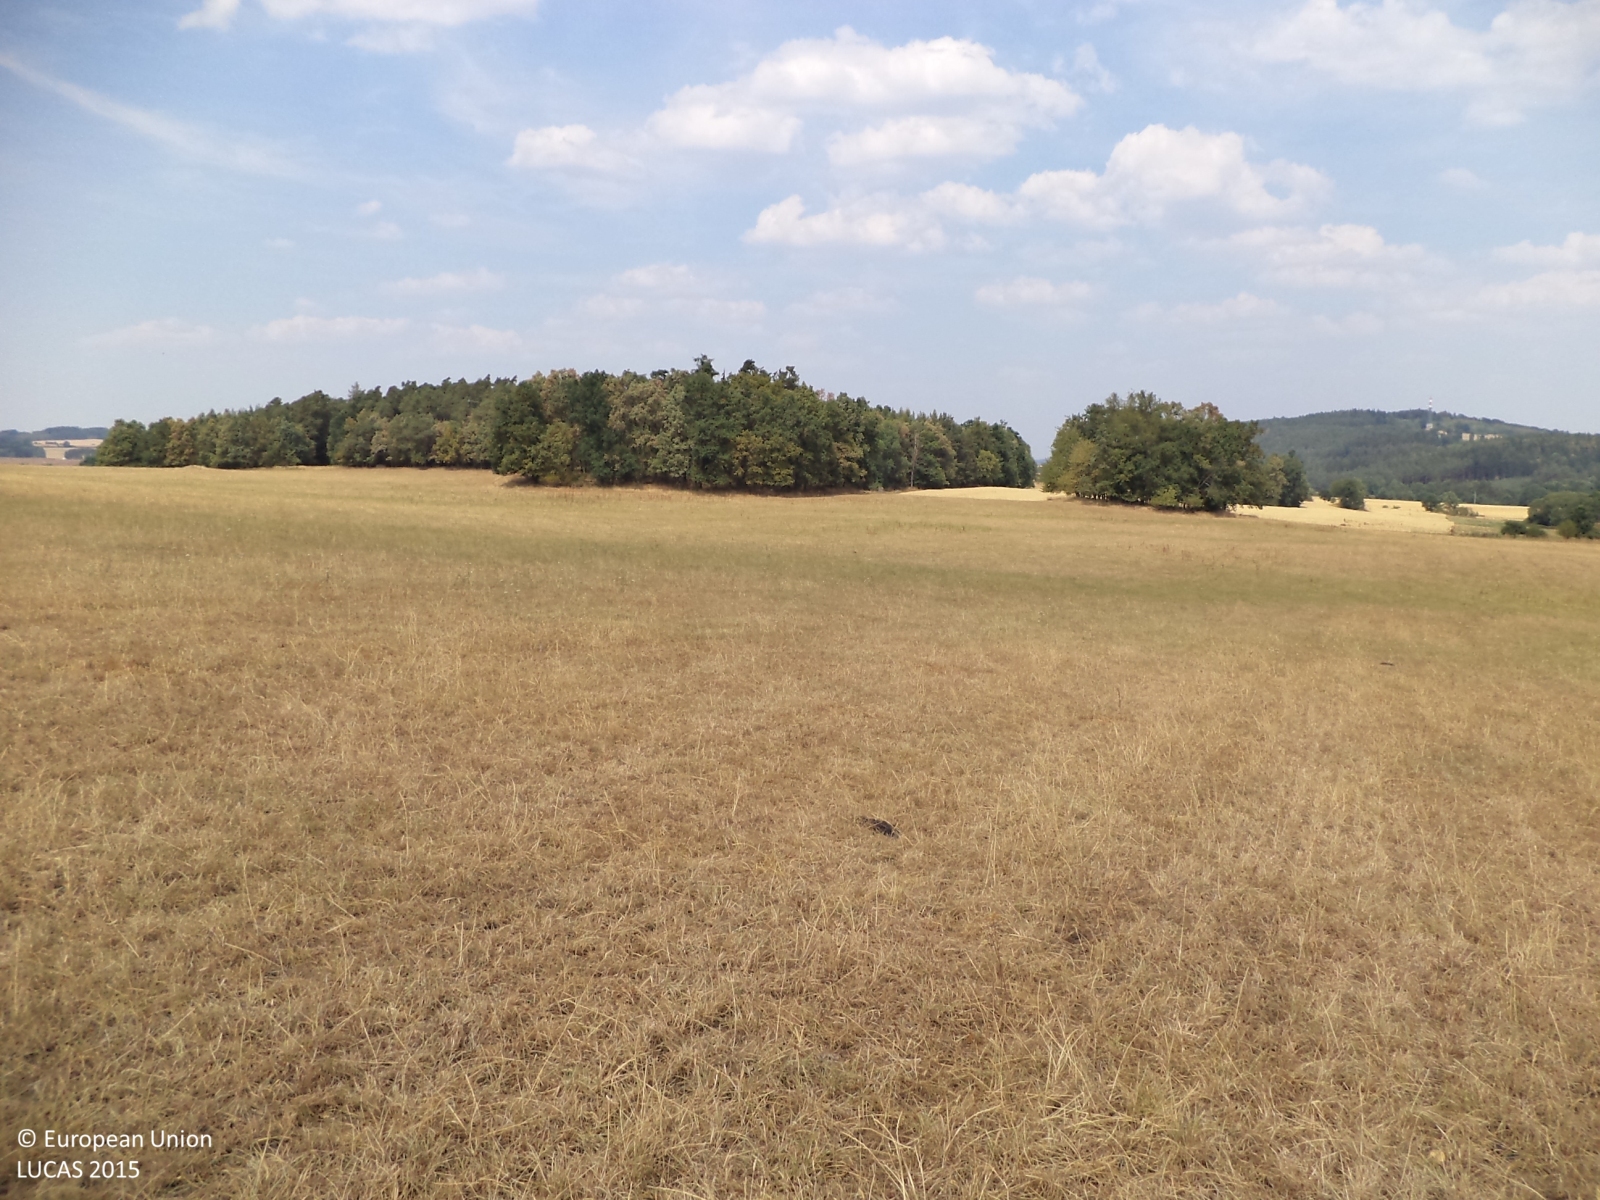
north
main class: Grassland
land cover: Grassland without tree/shrub cover
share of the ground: > 75 %
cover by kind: herbaceous plants 100 %
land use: Agriculture (excluding fallow land and kitchen gardens)
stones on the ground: < 10 %
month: August
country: CZ
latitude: 49.5449
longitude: 14.2994
